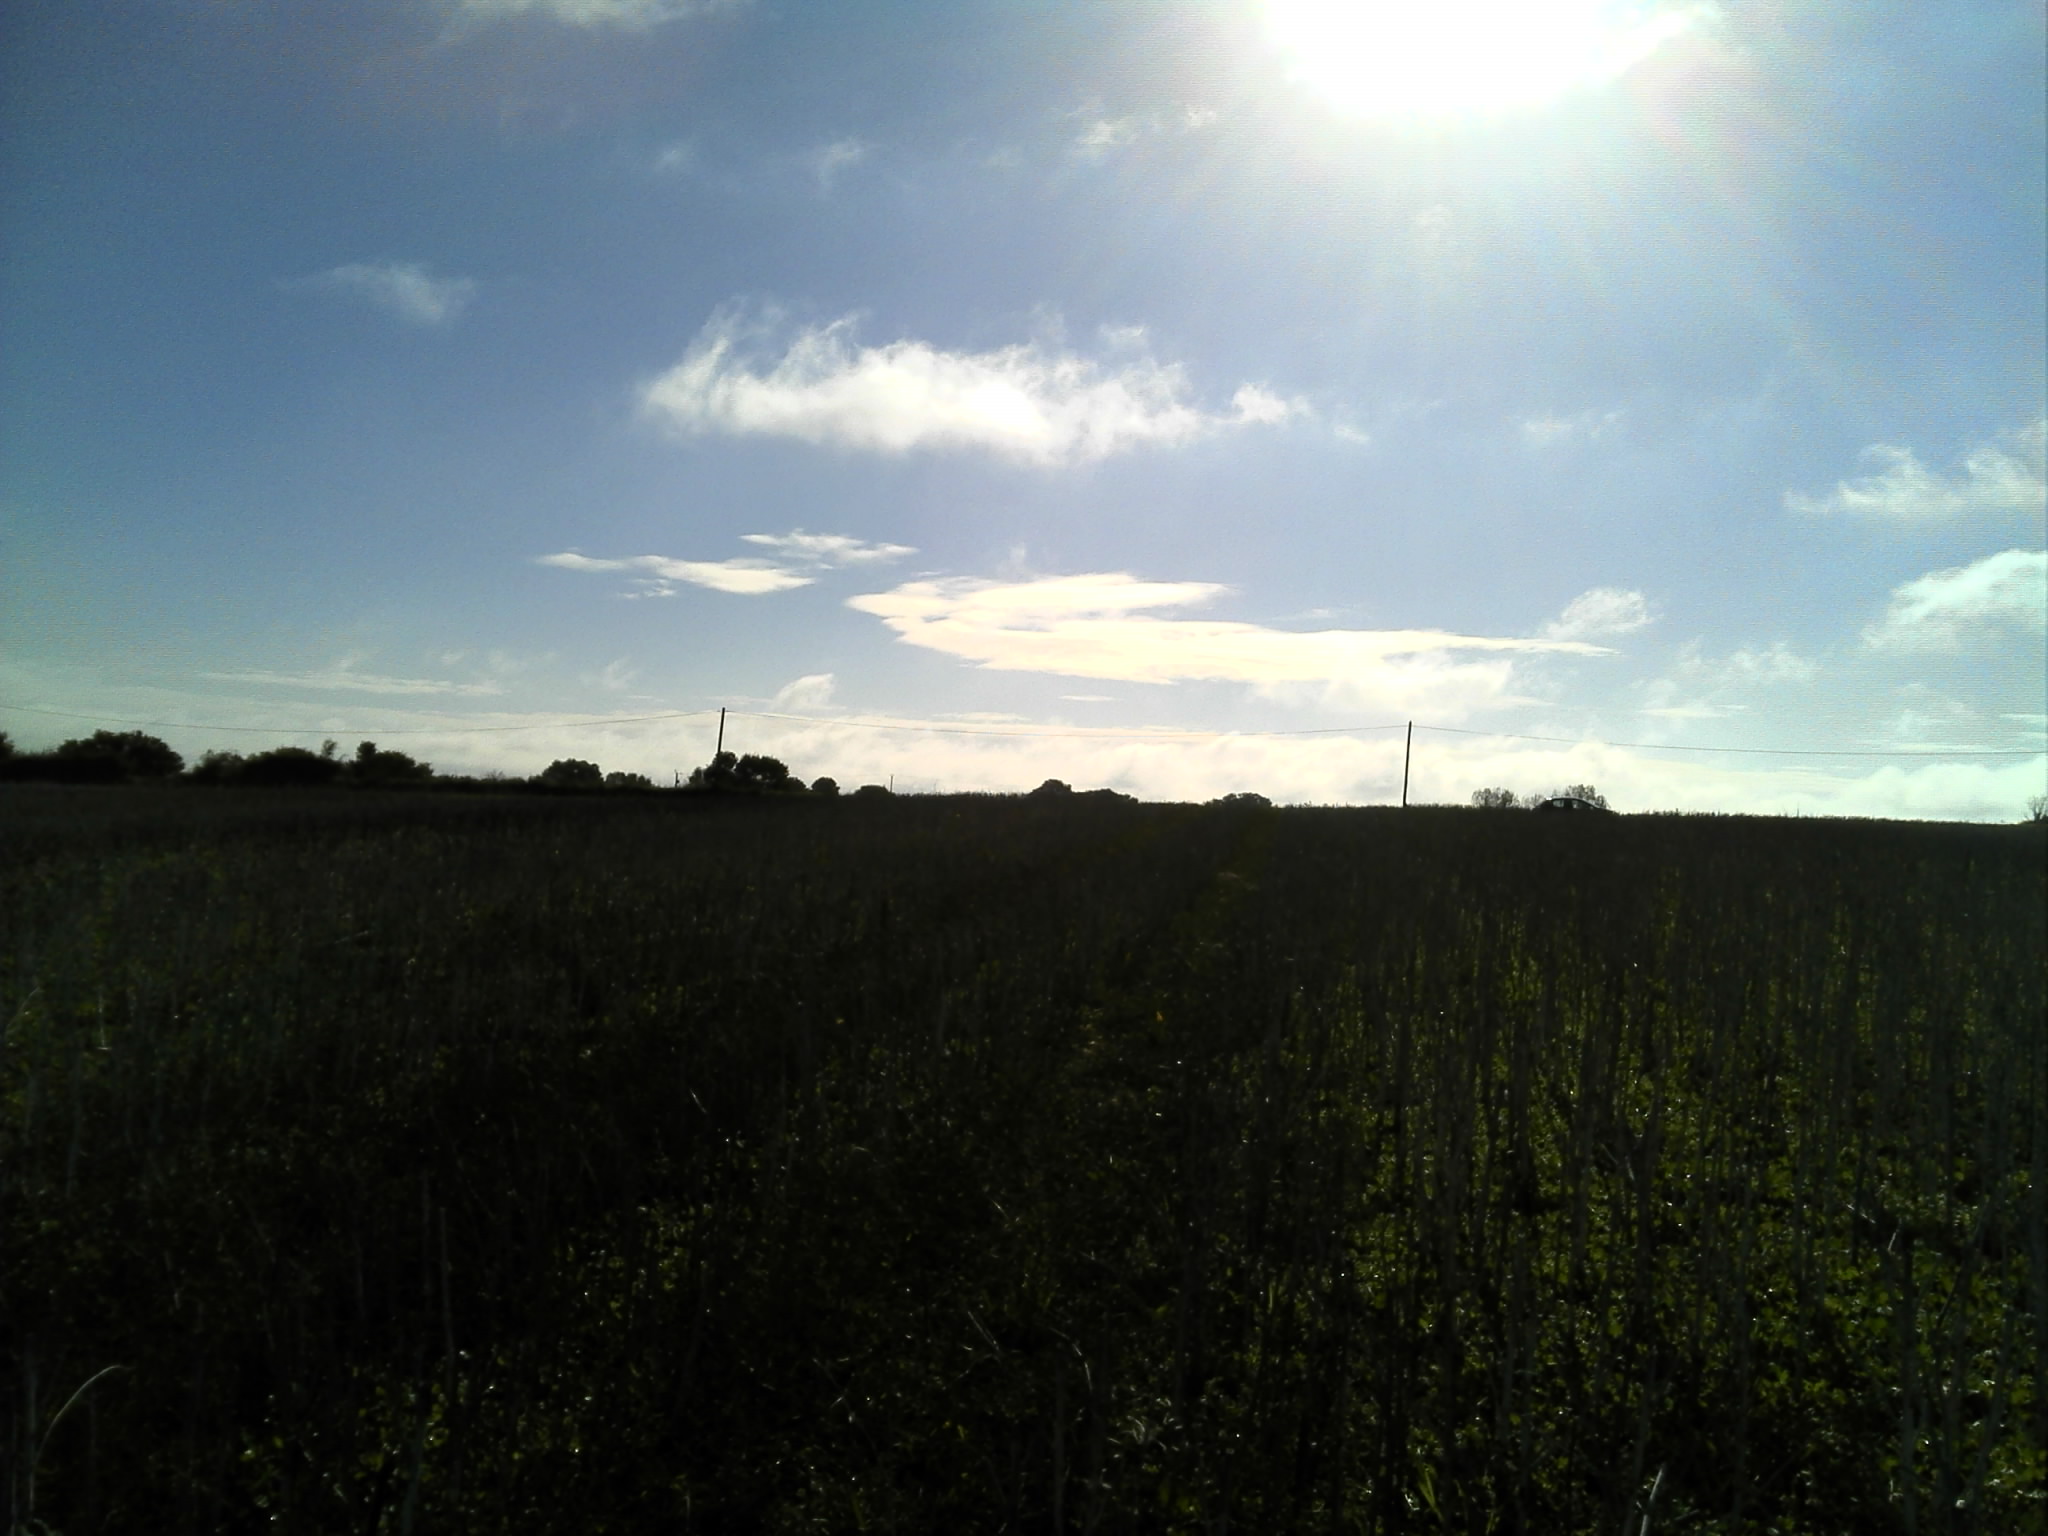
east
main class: Cropland
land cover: Rape and turnip rape
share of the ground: > 75 %
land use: Agriculture (excluding fallow land and kitchen gardens)
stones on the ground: < 10 %
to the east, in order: Rape and turnip rape; Grass margins; Paved roads, cycling and walking lanes; Grass margins; Electric lines; Common wheat; Abandoned hedges; Common wheat
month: September
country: FR
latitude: 47.9563
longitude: 0.6984
